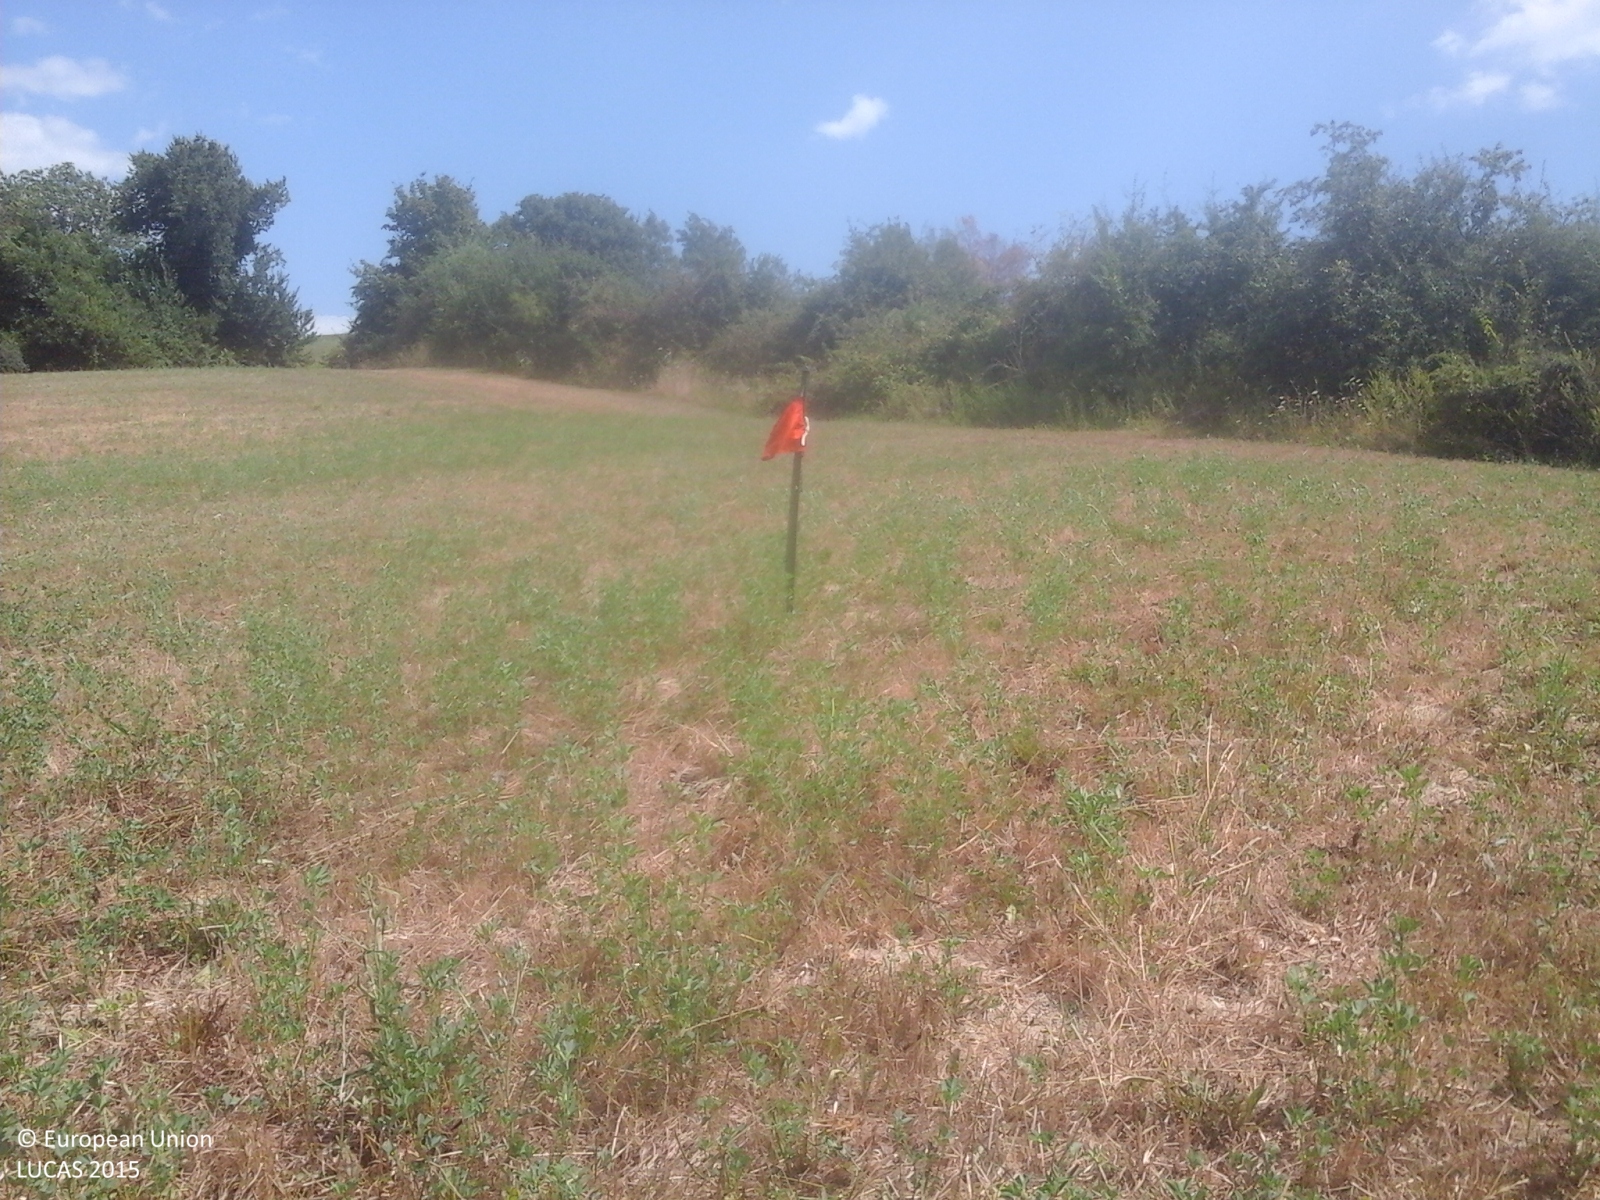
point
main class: Cropland
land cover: Lucerne
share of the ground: > 75 %
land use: Agriculture (excluding fallow land and kitchen gardens)
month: July
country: IT
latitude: 43.8663
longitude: 12.6192
